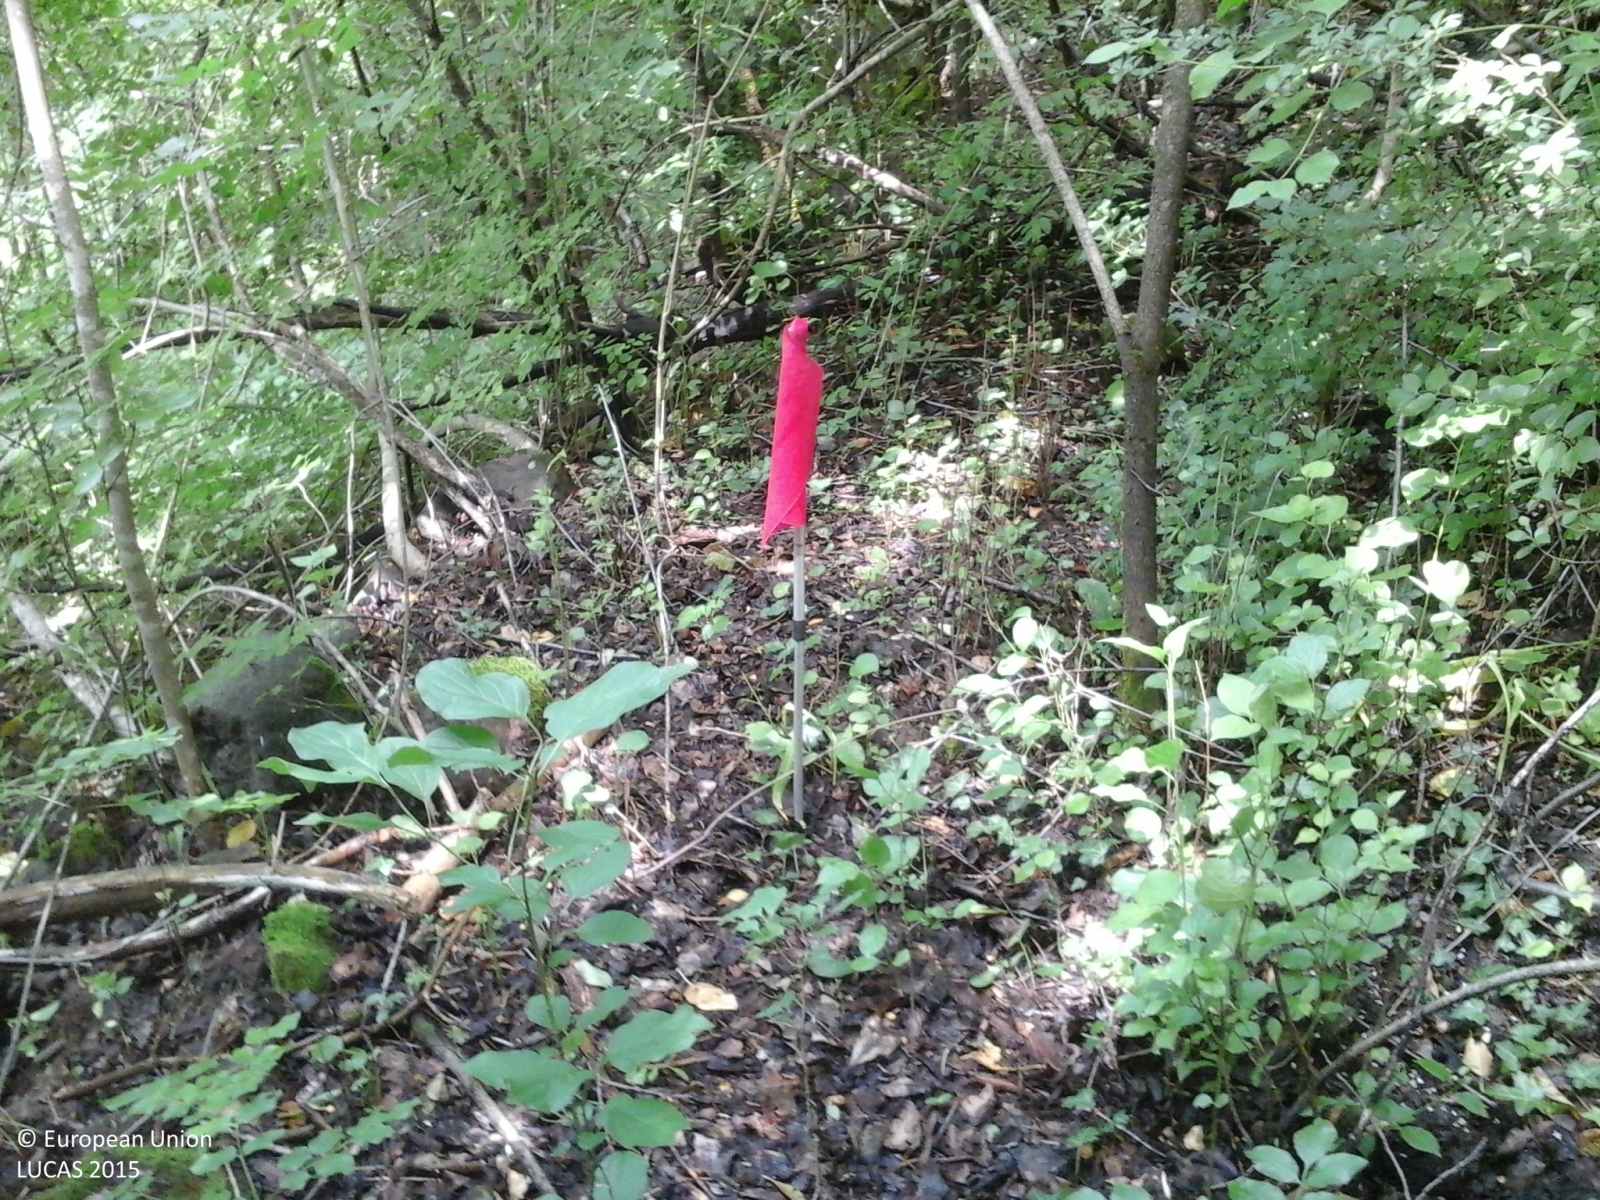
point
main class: Woodland
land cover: Broadleaved woodland
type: thermophilous deciduous forest
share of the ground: > 75 %
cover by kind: broadleaved forest trees 100 %
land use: Forestry
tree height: > 5 m
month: June
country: IT
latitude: 46.1997
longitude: 11.2553
